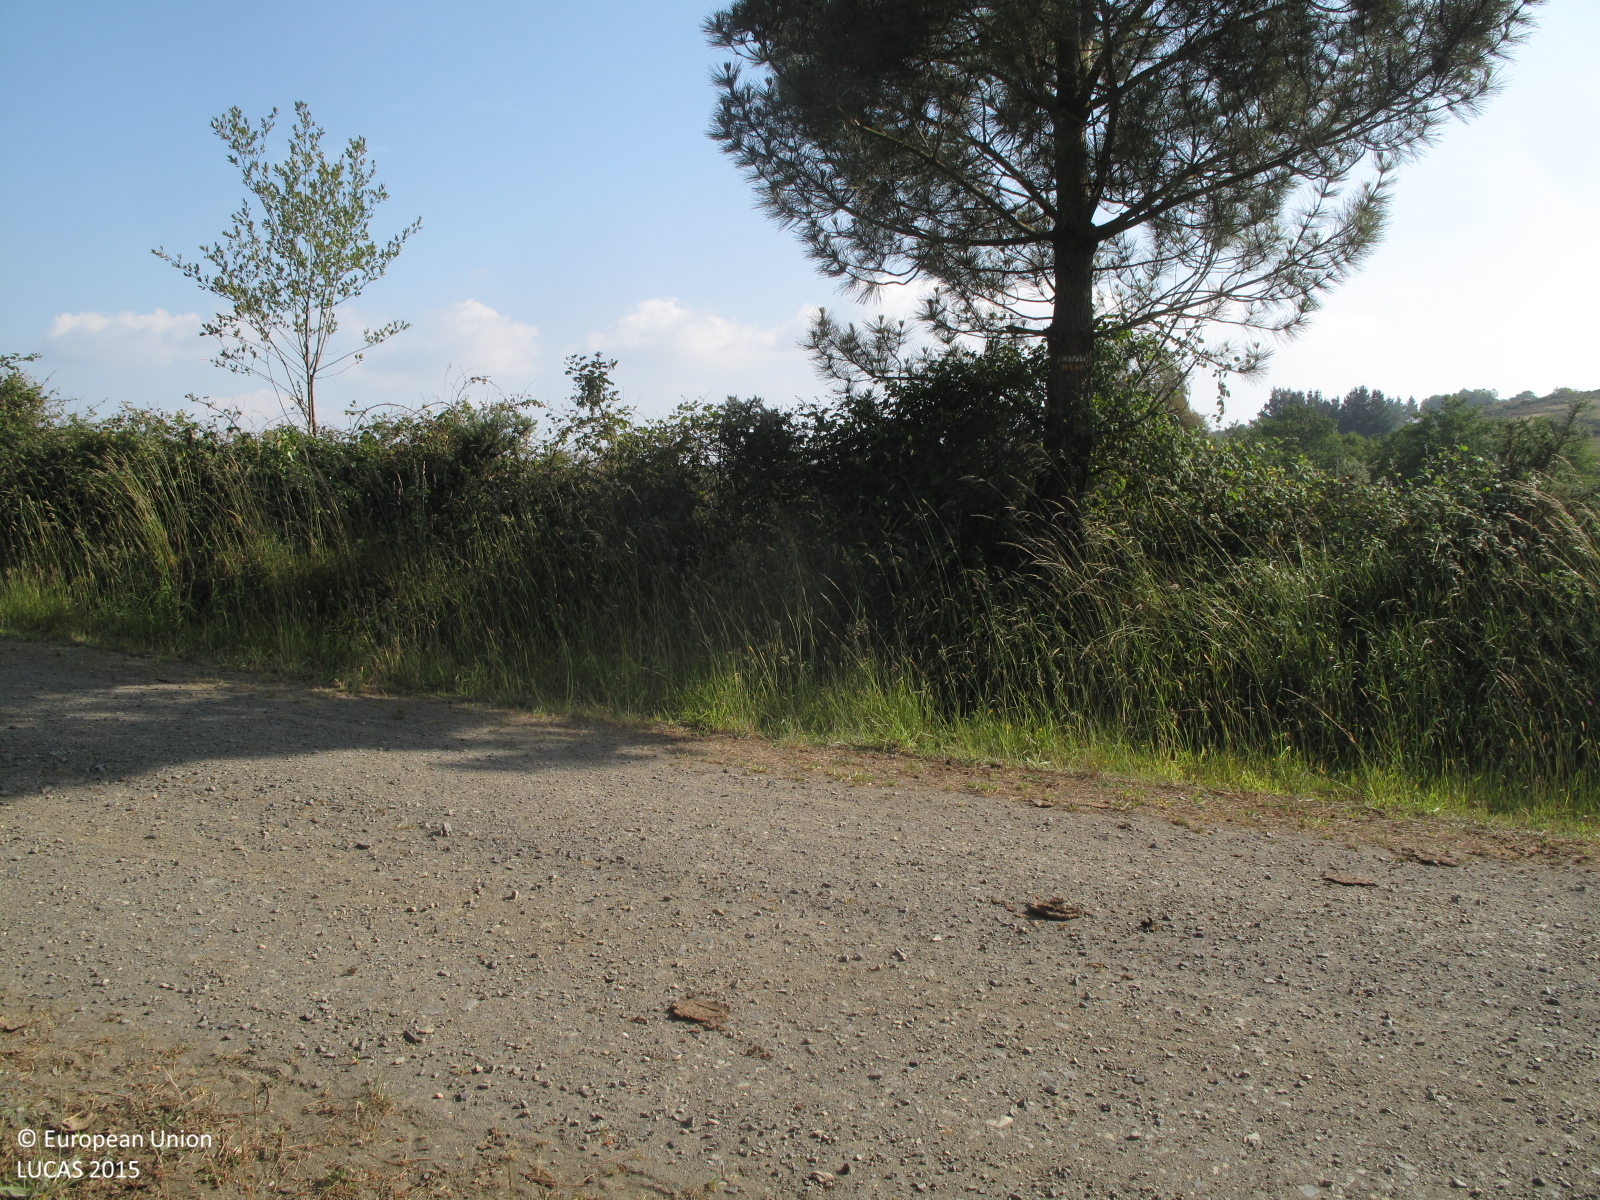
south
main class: Woodland
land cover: Broadleaved woodland
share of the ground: 25 - 50 %
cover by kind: broadleaved forest trees 40 %, shrubs 40 %, herbaceous plants 20 %
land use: Forestry
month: June
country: ES
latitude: 43.0111
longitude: -7.9395
